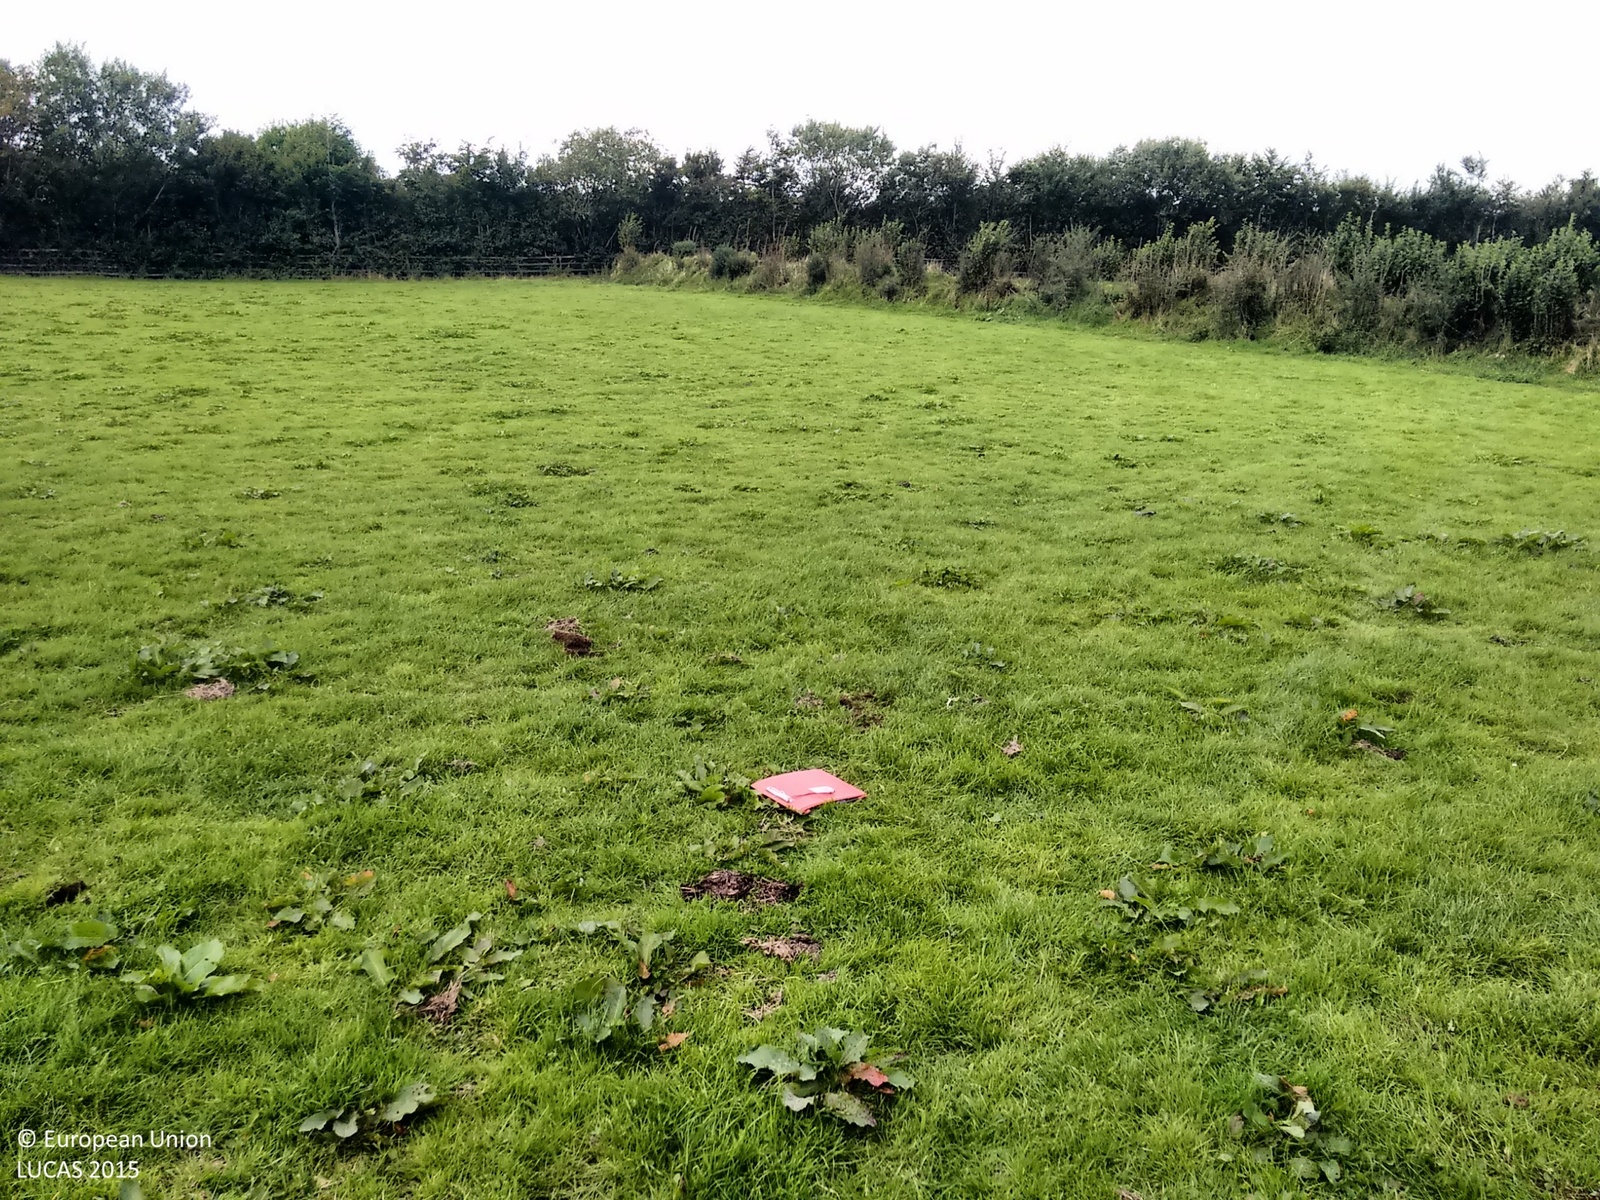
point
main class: Grassland
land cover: Grassland without tree/shrub cover
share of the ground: > 75 %
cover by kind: herbaceous plants 100 %
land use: Agriculture (excluding fallow land and kitchen gardens)
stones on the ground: < 10 %
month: September
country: GB
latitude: 50.7151
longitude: -4.0454
